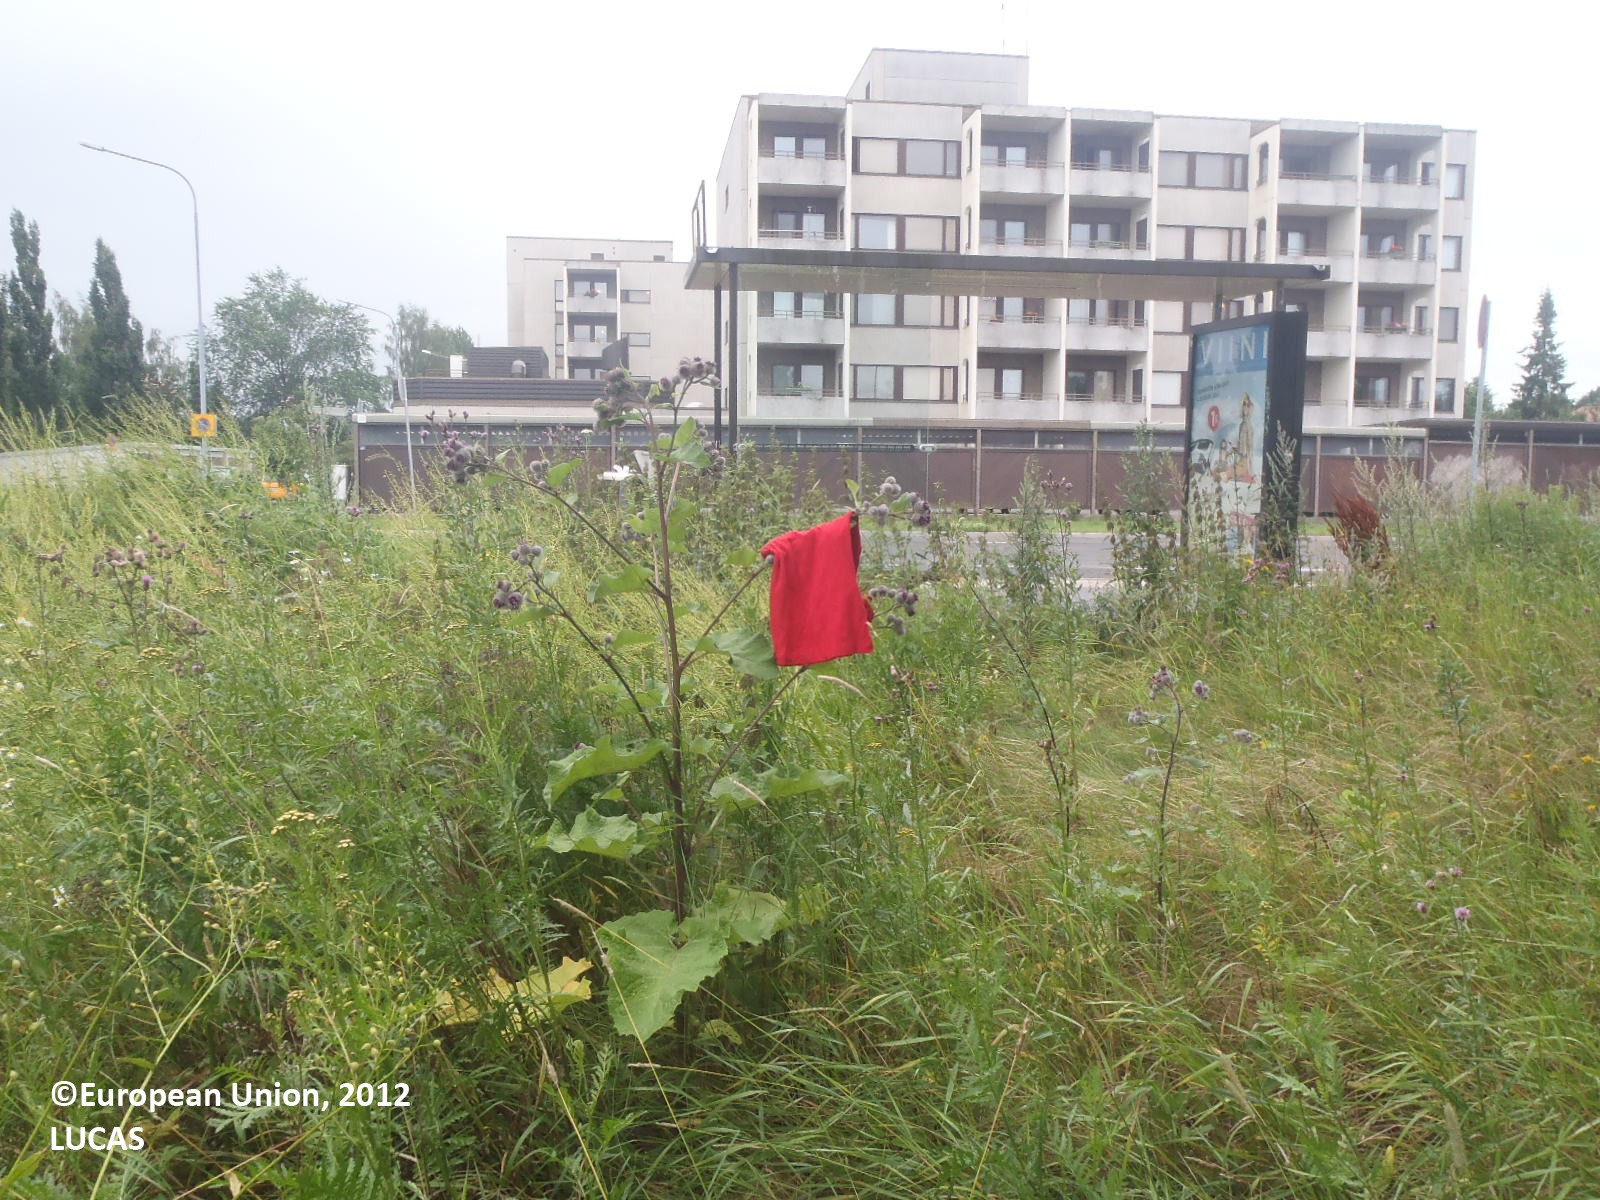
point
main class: Grassland
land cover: Grassland without tree/shrub cover
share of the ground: > 75 %
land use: Abandoned areas
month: July
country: FI
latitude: 60.4432
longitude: 22.2985
